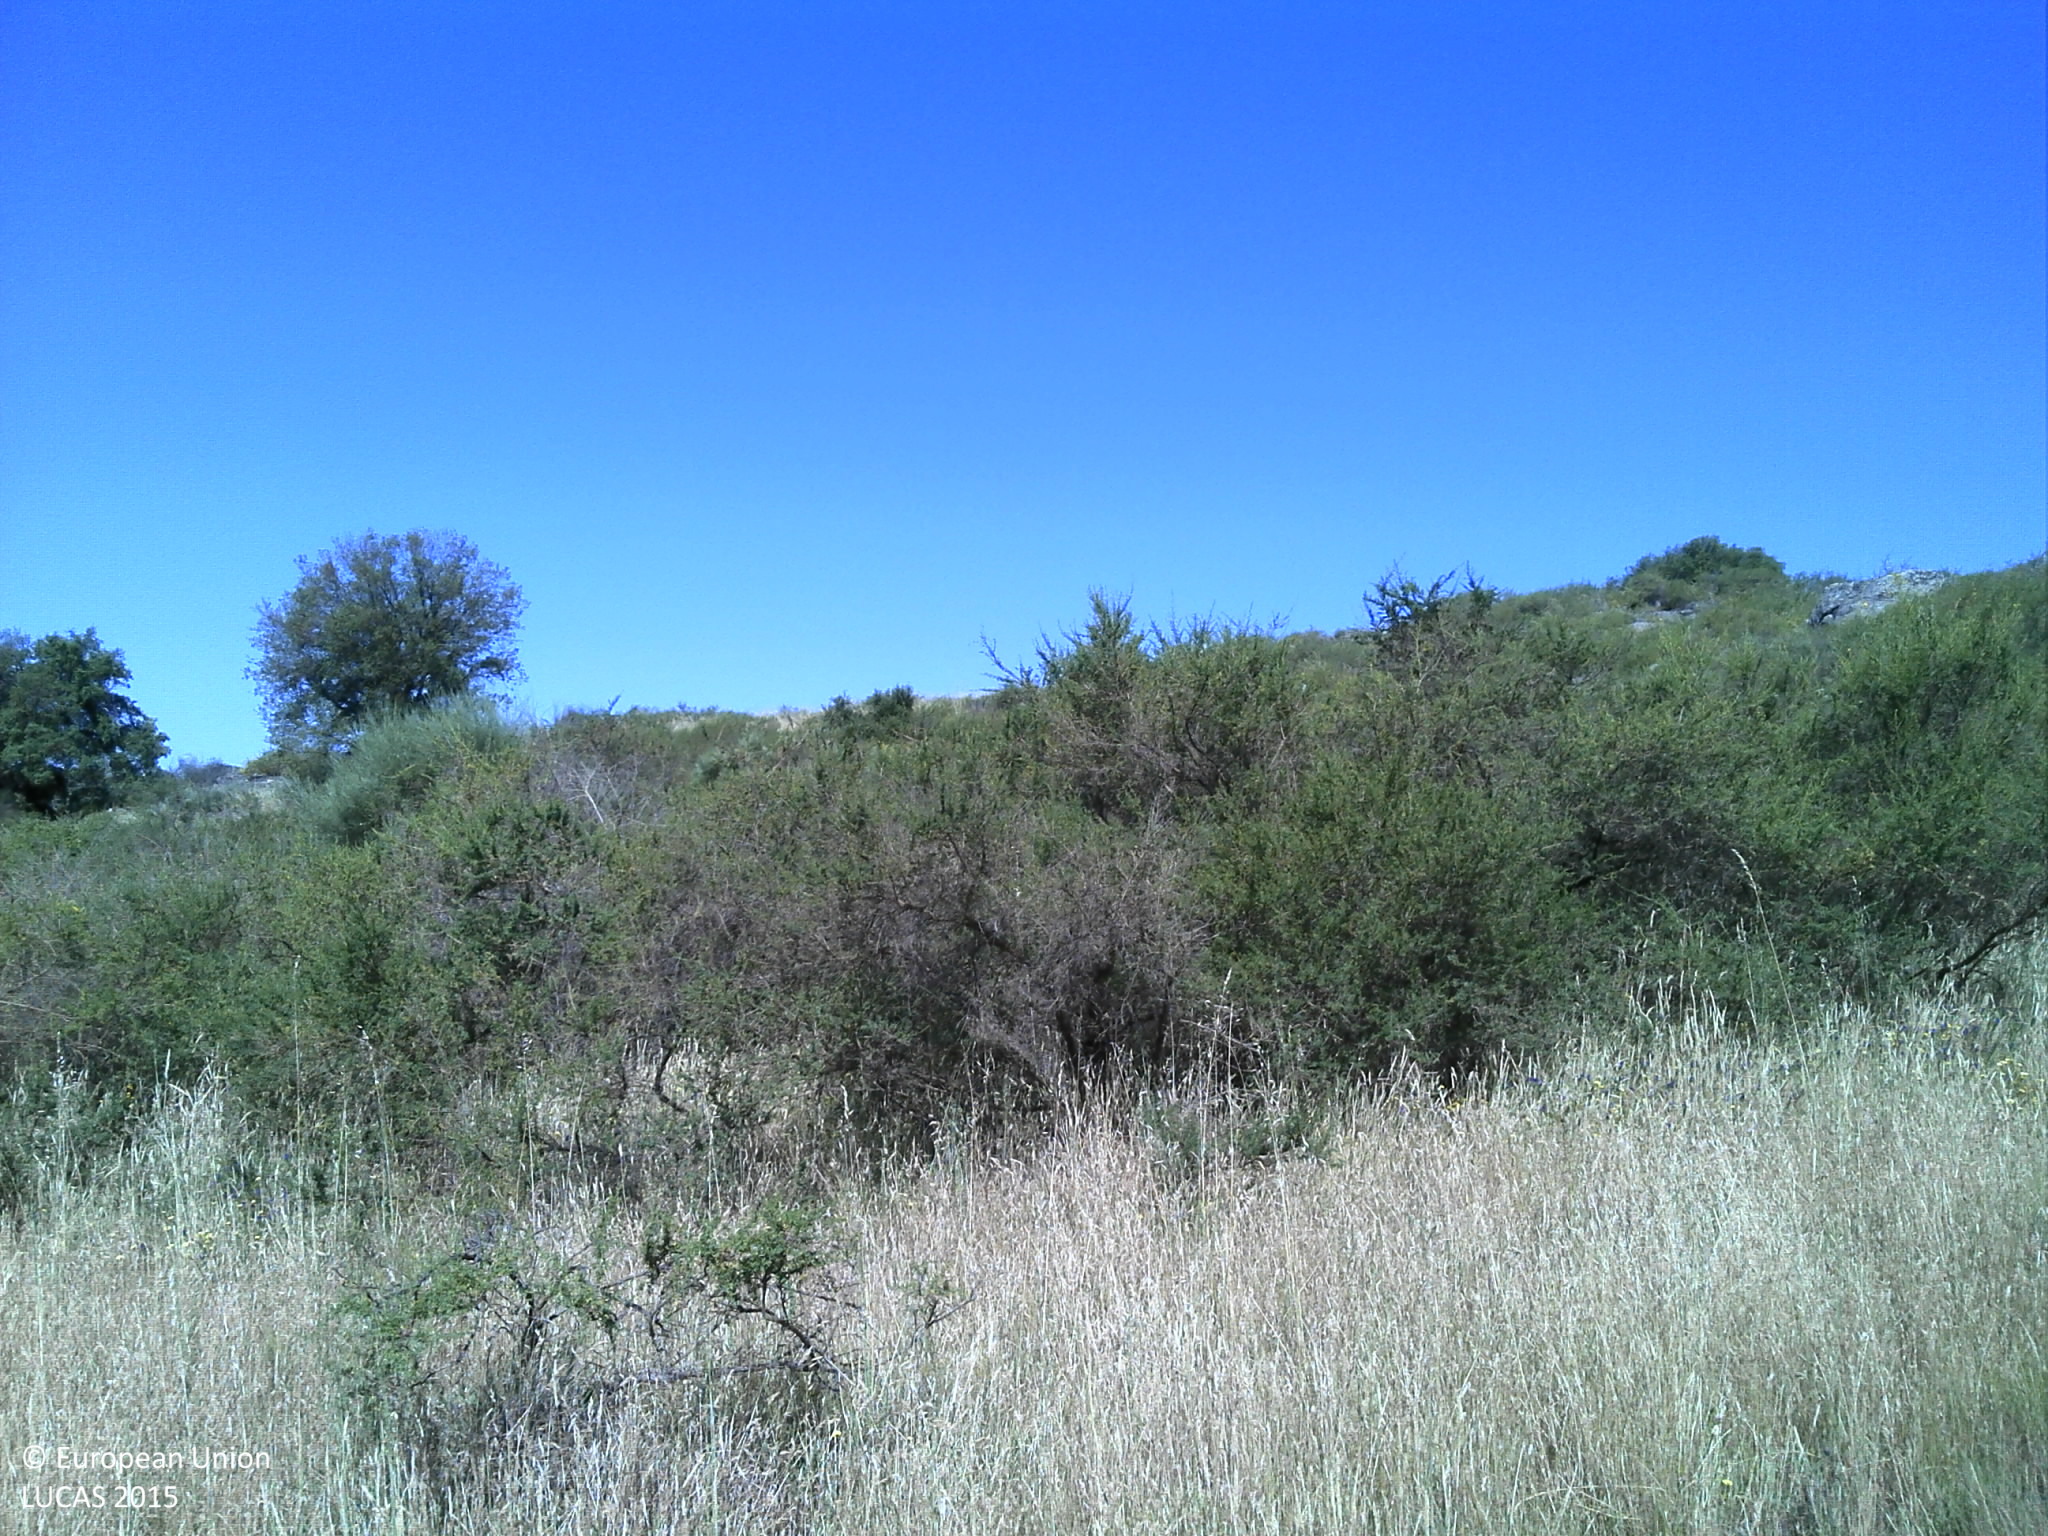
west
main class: Grassland
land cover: Grassland without tree/shrub cover
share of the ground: 25 - 50 %
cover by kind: herbaceous plants 55 %, unconsolidated bare surface 40 %, shrubs 5 %
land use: Agriculture (excluding fallow land and kitchen gardens)
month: May
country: PT
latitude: 39.4855
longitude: -7.6409
